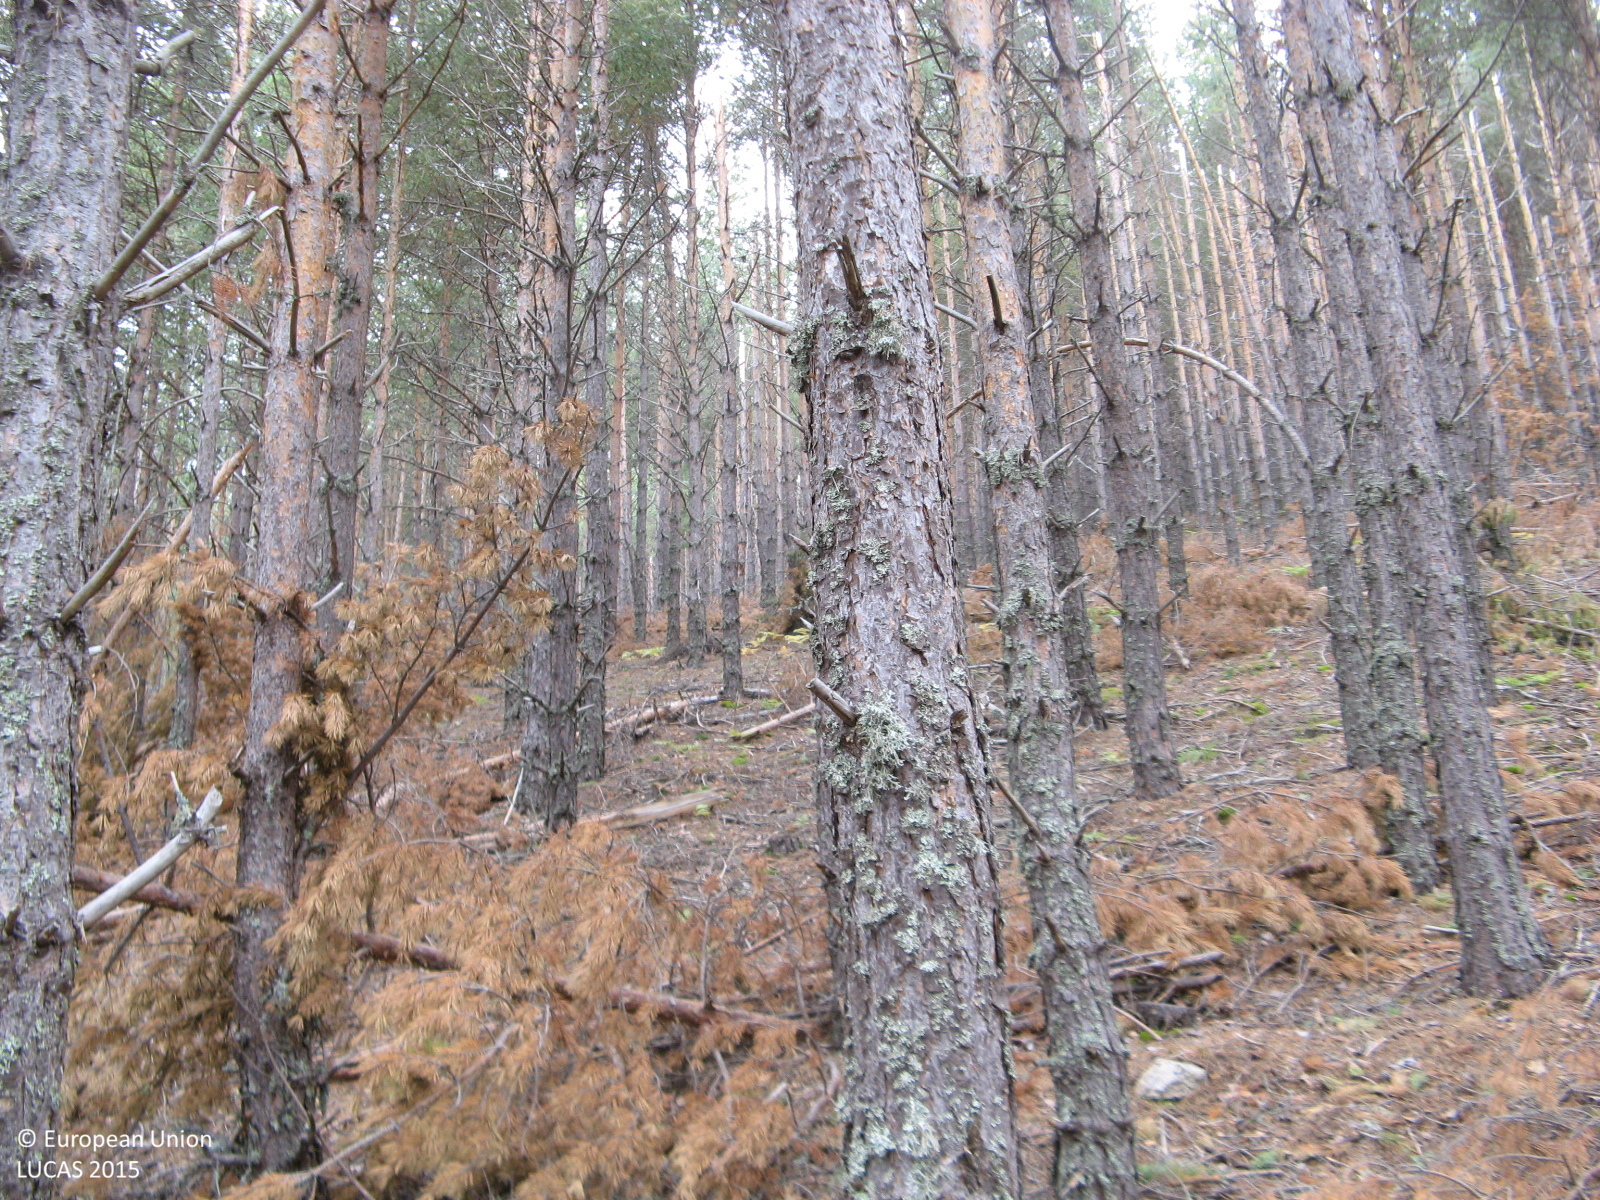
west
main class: Woodland
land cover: Pine dominated coniferous woodland
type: alpine coniferous forest
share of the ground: > 75 %
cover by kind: coniferous forest trees 95 %, unconsolidated bare surface 5 %
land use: Forestry
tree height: > 5 m
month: October
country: BG
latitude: 41.7318
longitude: 24.5053
